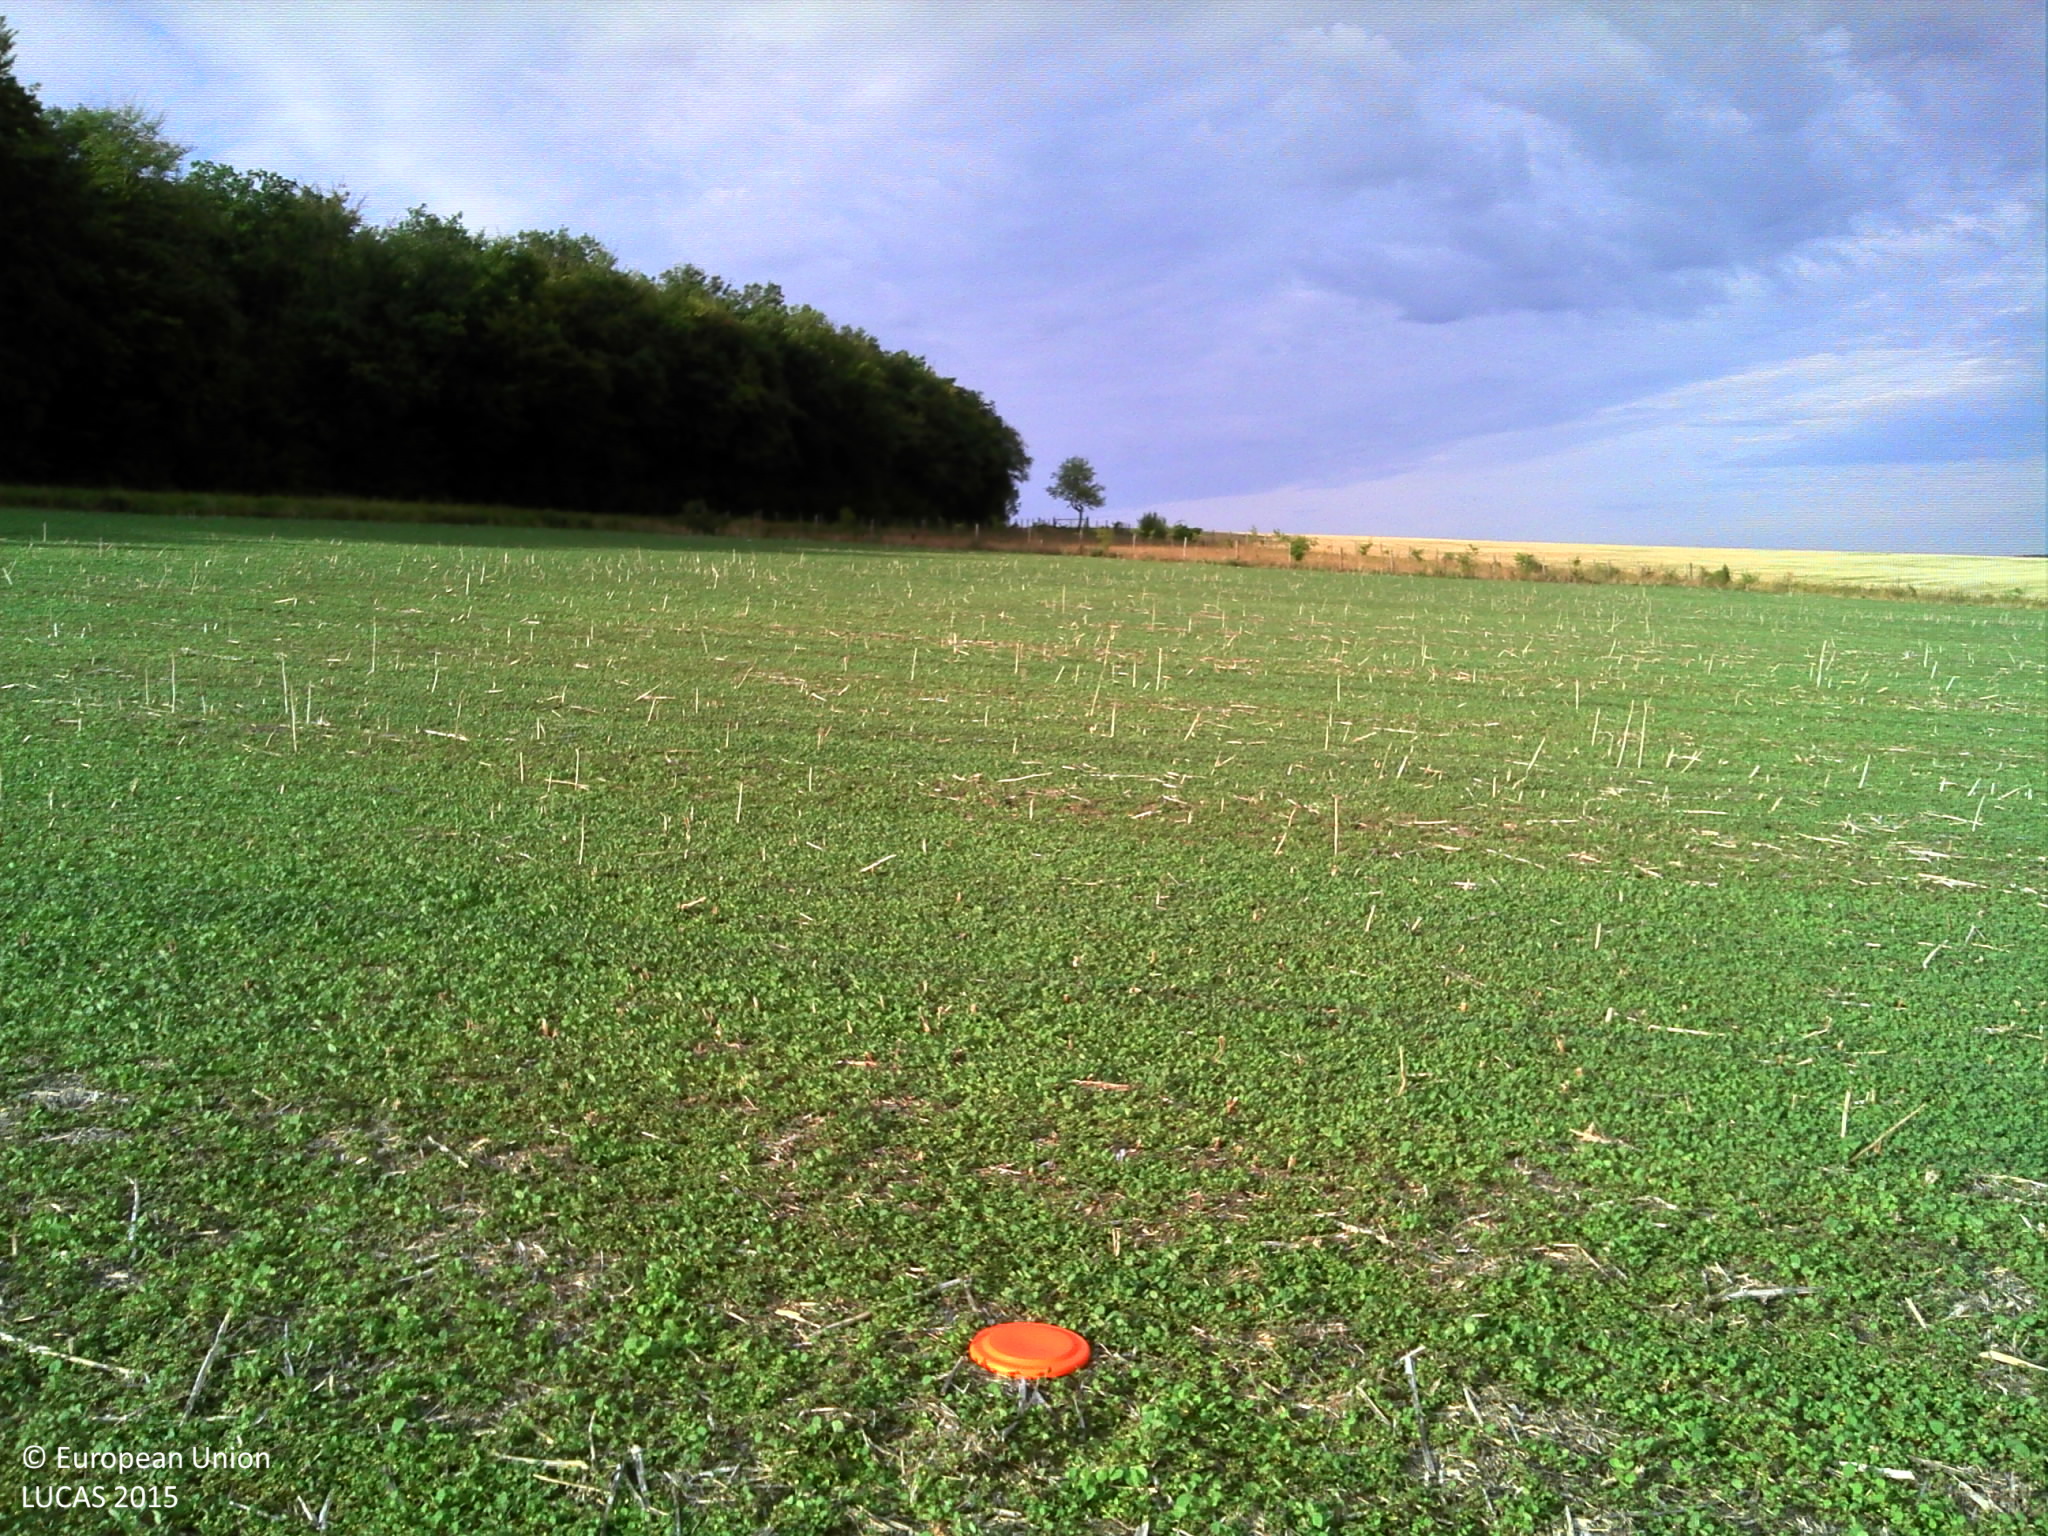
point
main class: Cropland
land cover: Rape and turnip rape
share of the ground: 25 - 50 %
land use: Agriculture (excluding fallow land and kitchen gardens)
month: August
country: FR
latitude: 47.6485
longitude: 4.7675
